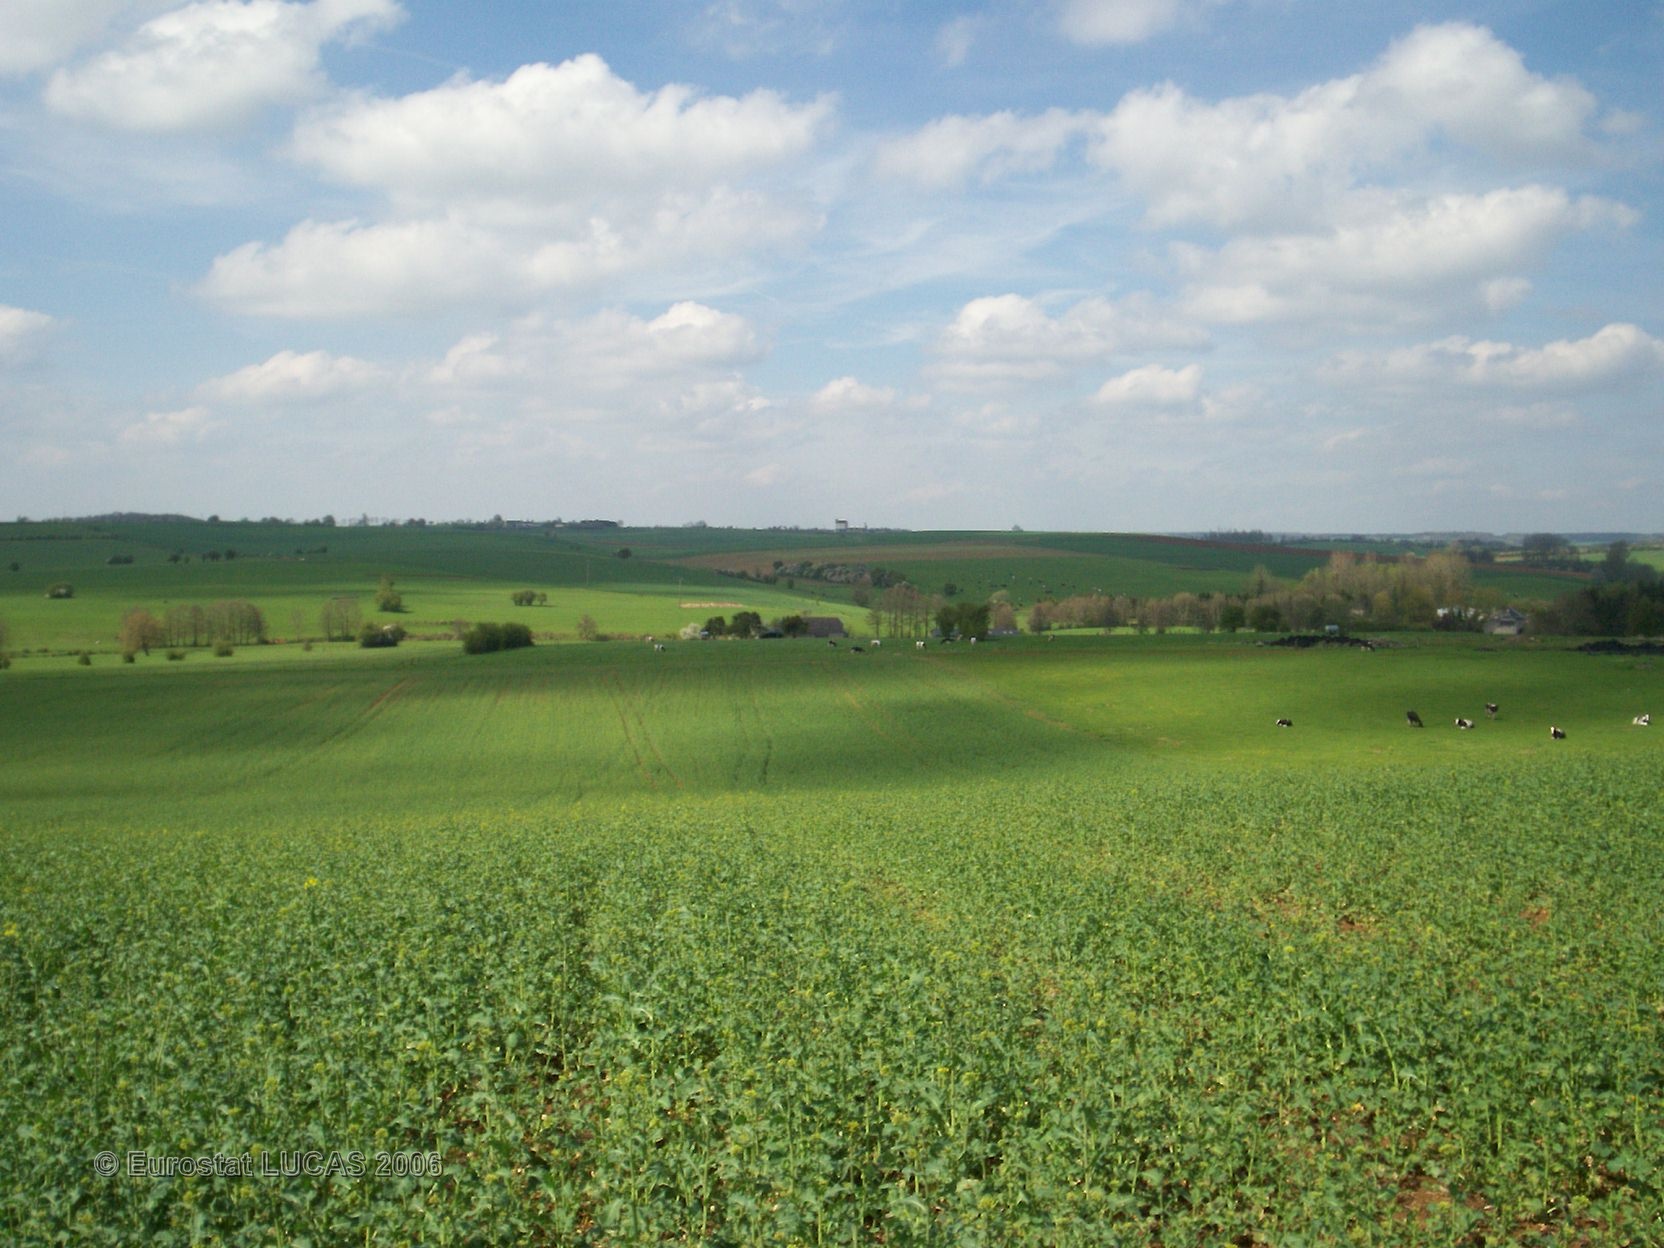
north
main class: Cropland
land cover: Rape and turnip rape
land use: Agriculture (excluding fallow land and kitchen gardens)
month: May
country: FR
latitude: 49.8438
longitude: 4.3080
